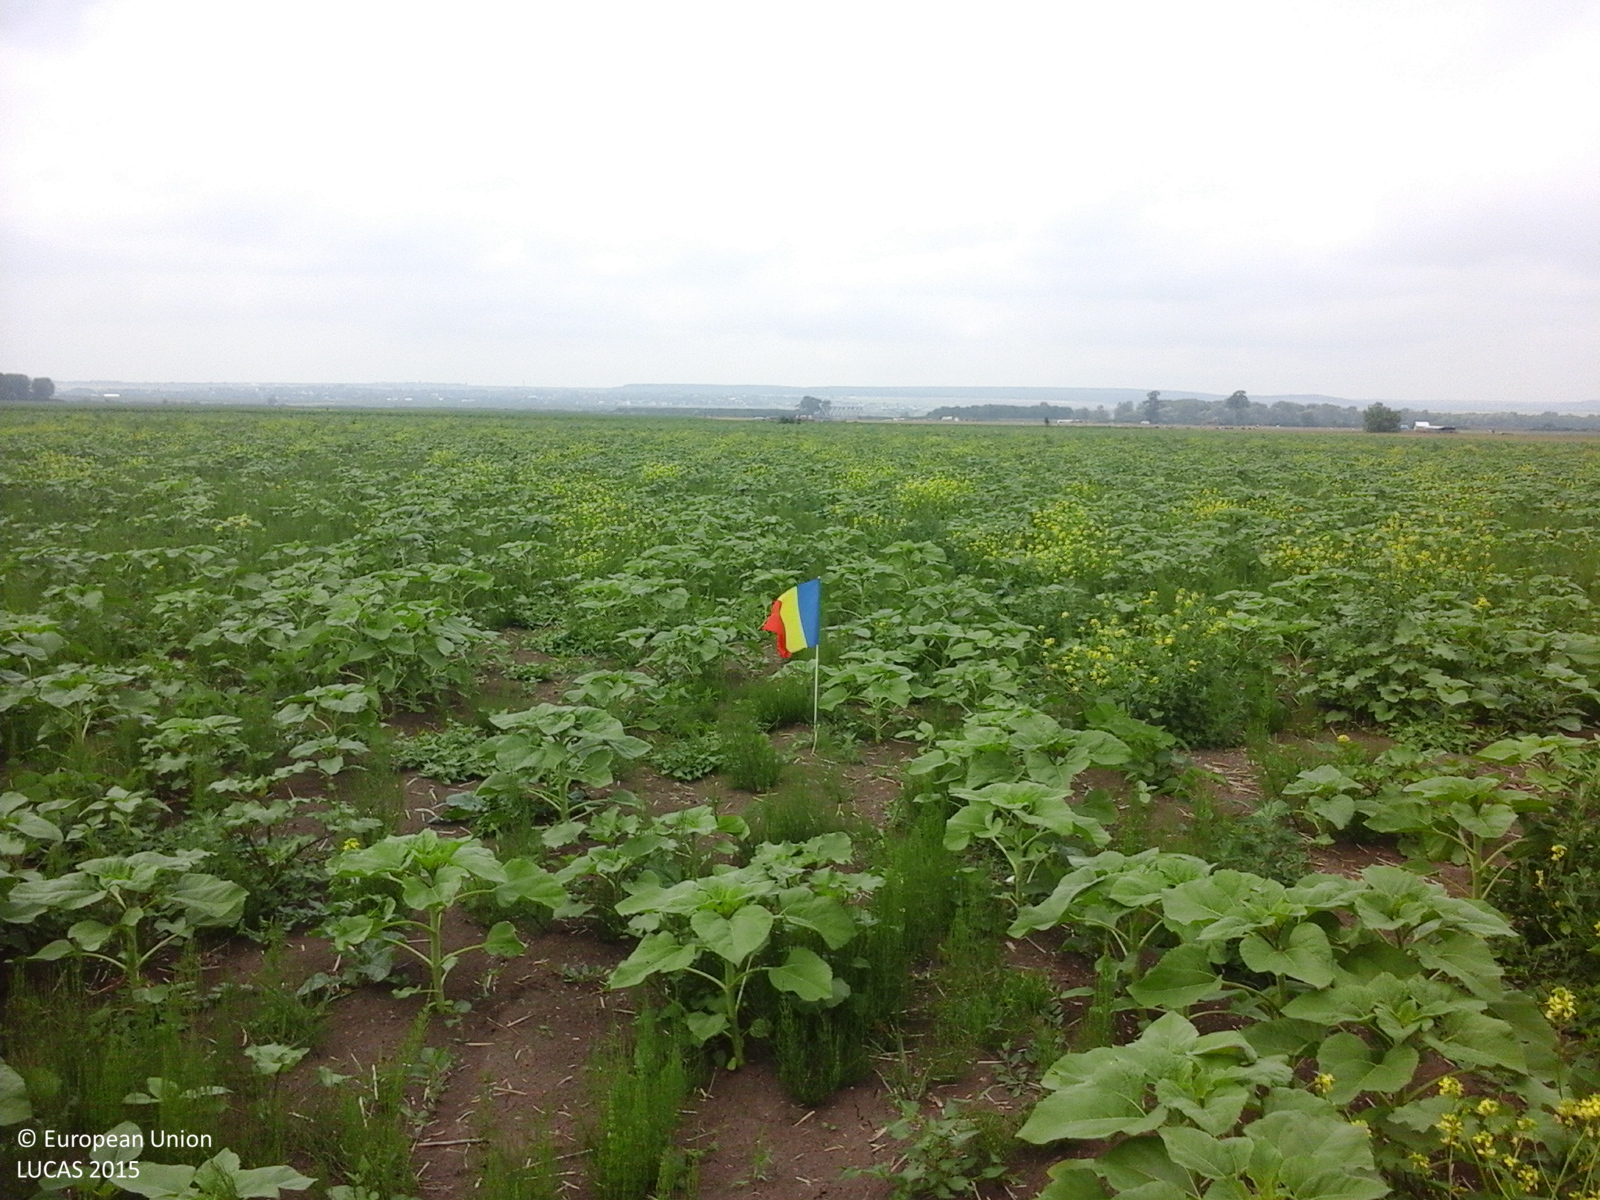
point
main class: Cropland
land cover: Sunflower
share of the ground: 25 - 50 %
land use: Agriculture (excluding fallow land and kitchen gardens)
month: June
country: RO
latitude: 47.7295
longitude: 26.4489
